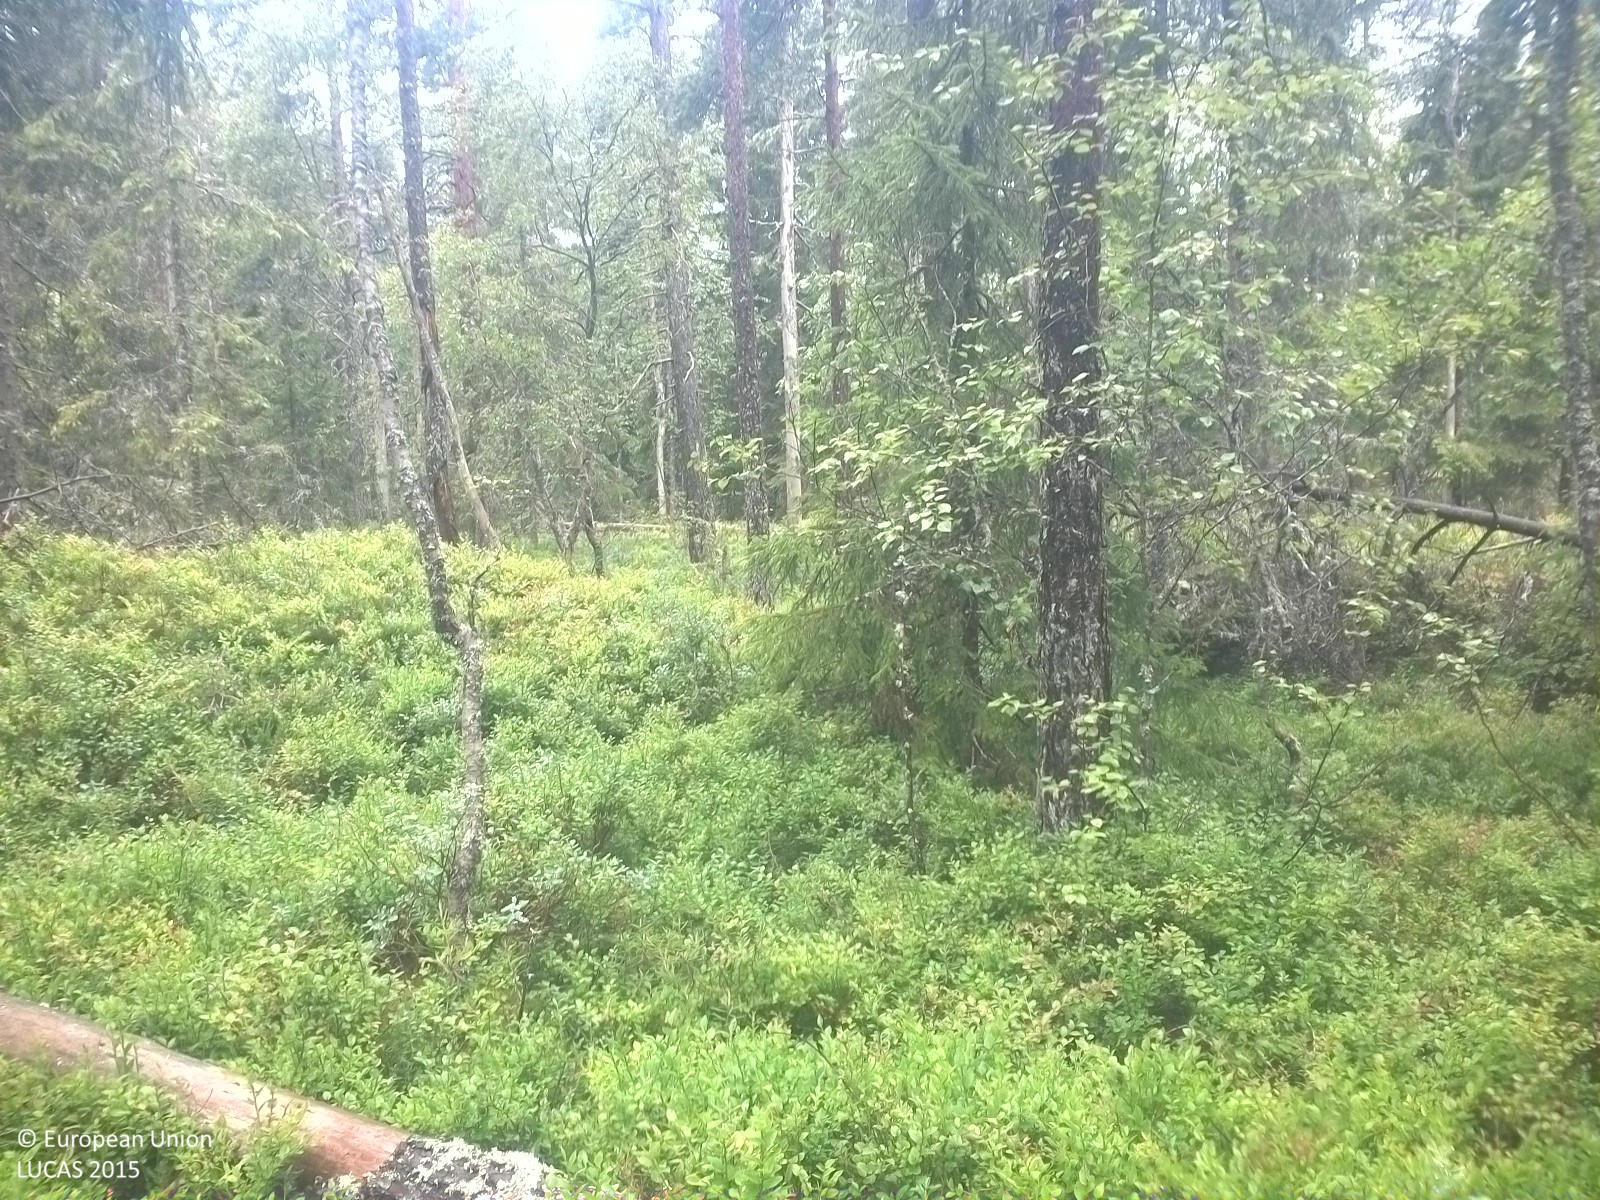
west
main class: Woodland
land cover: Pine dominated mixed woodland
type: boreal forest
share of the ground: 25 - 50 %
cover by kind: herbaceous plants 40 %, coniferous forest trees 25 %, shrubs 15 %, broadleaved forest trees 10 %, lichens and mosses 10 %
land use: Forestry
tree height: > 5 m
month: July
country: SE
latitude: 58.8246
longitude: 15.1367
